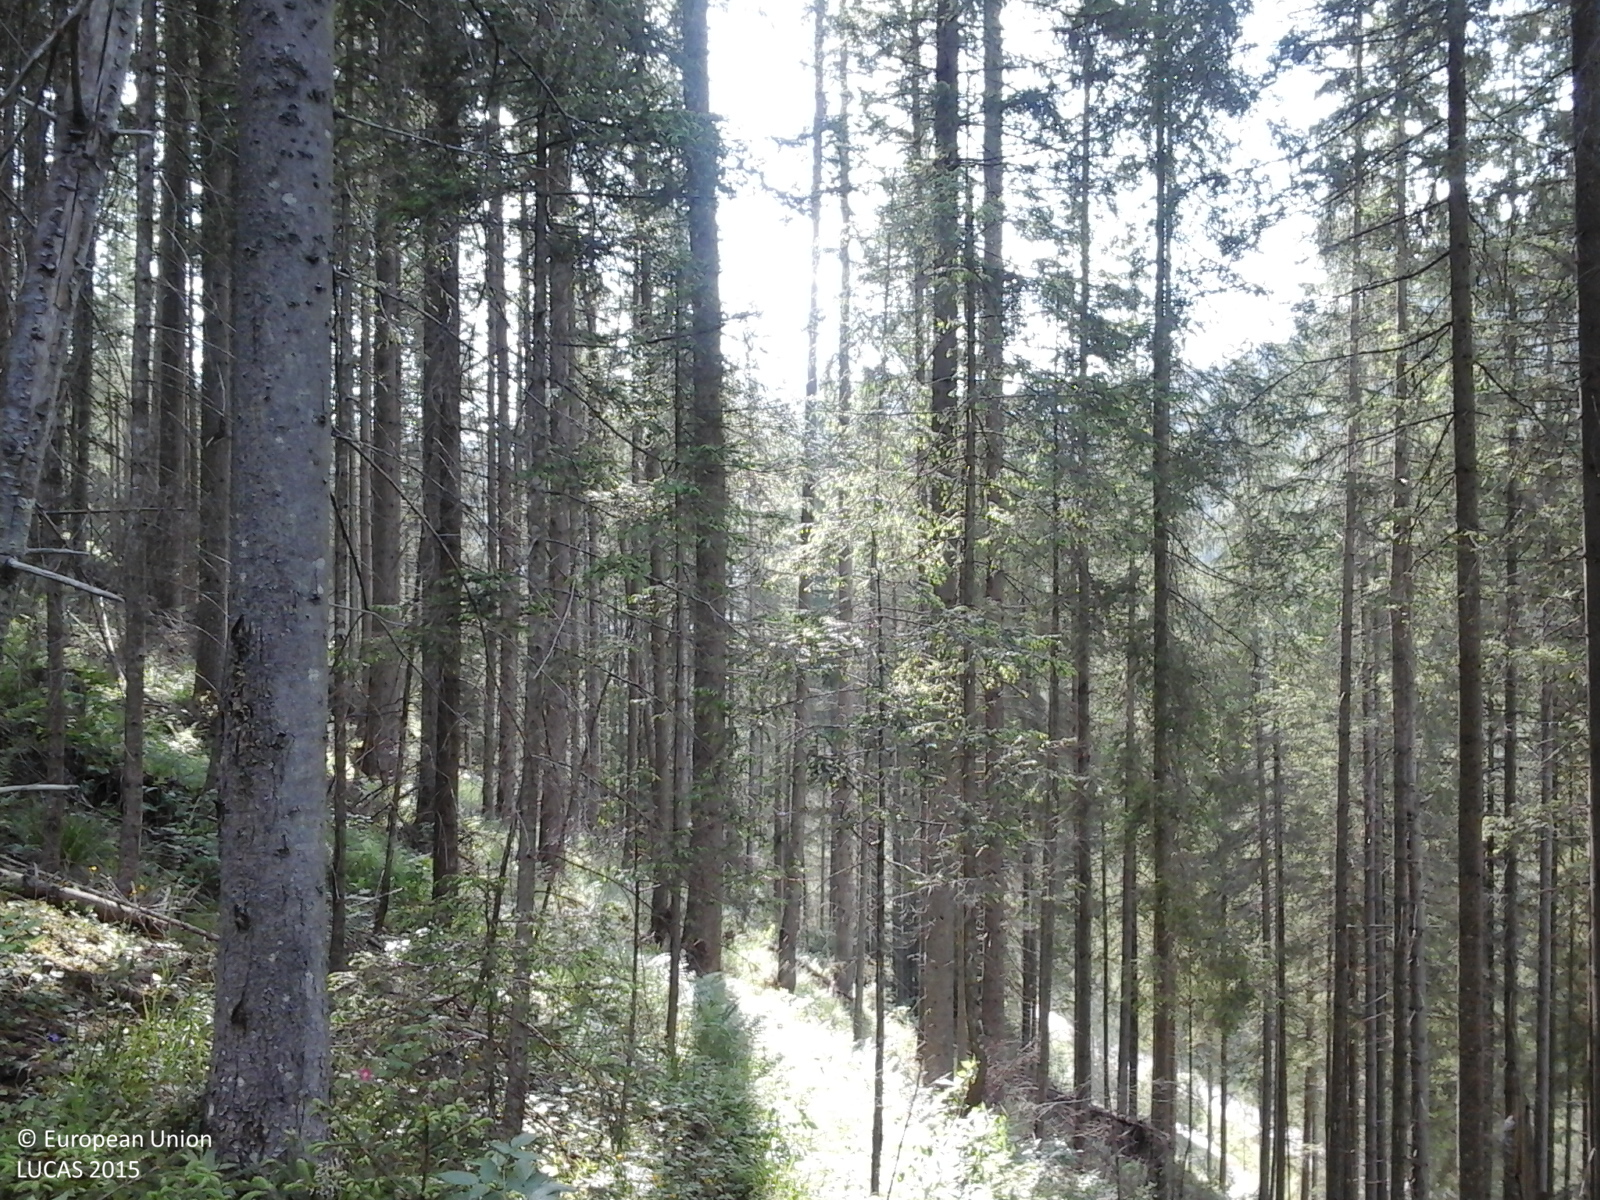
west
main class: Woodland
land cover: Spruce dominated coniferous woodland
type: alpine coniferous forest
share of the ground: > 75 %
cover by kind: coniferous forest trees 100 %
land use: Forestry
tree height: > 5 m
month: June
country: RO
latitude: 47.1895
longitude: 25.5161
